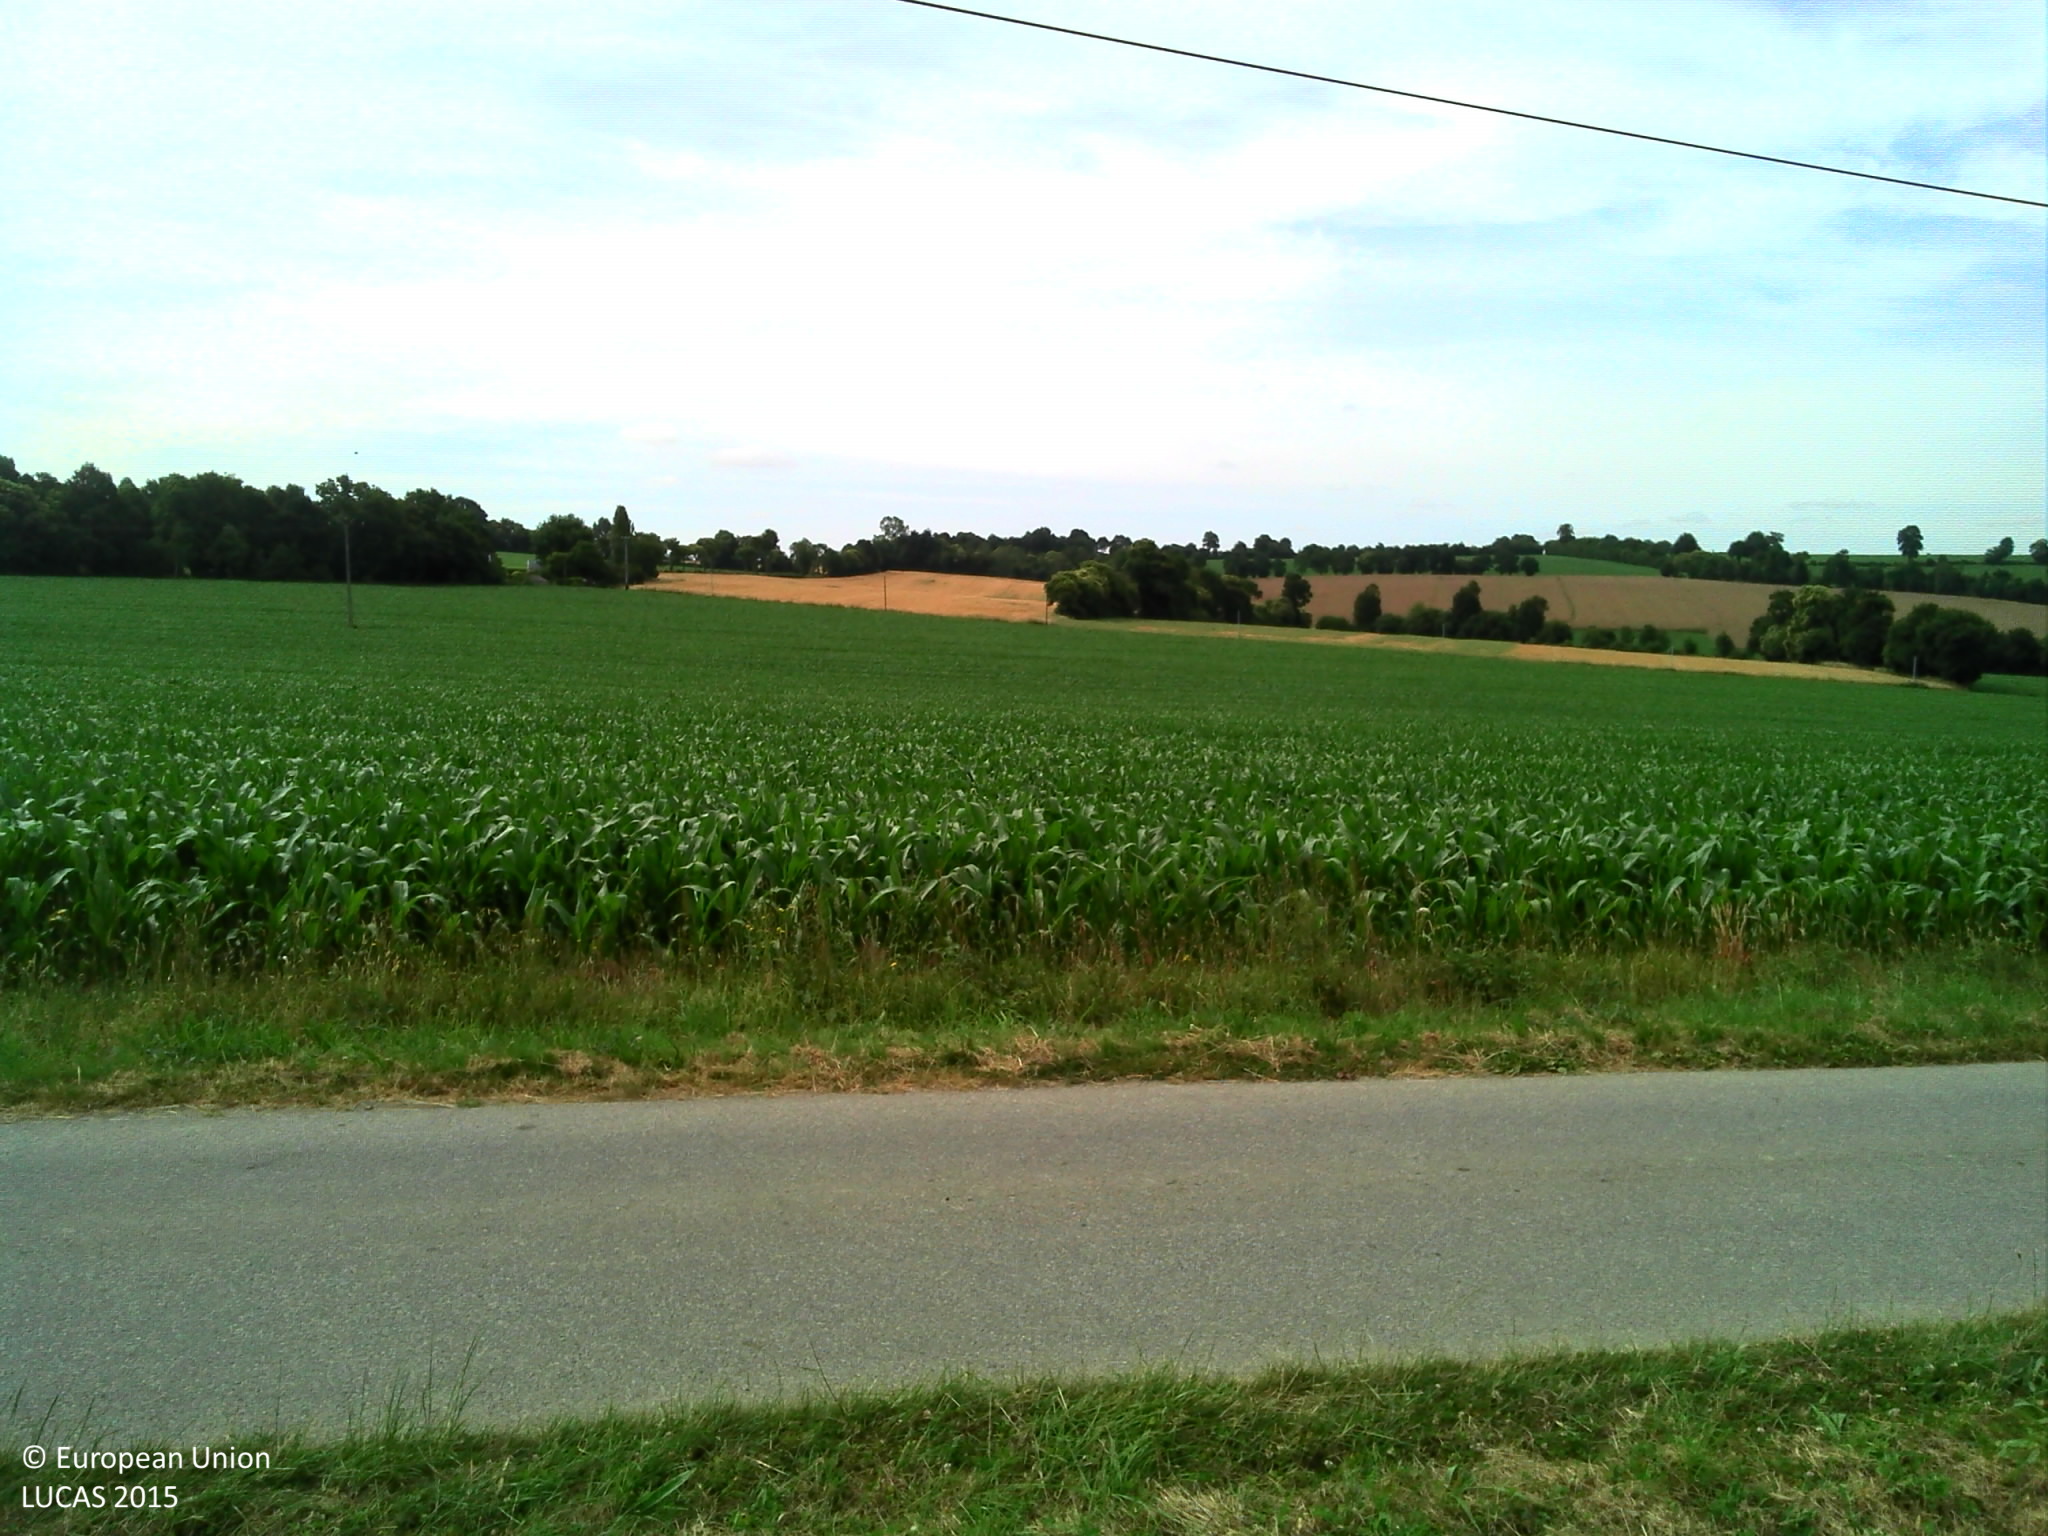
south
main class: Cropland
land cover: Apple fruit
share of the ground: > 75 %
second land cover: Grassland without tree/shrub cover
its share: > 75 %
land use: Agriculture (excluding fallow land and kitchen gardens)
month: June
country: FR
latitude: 47.9362
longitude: -1.5984
